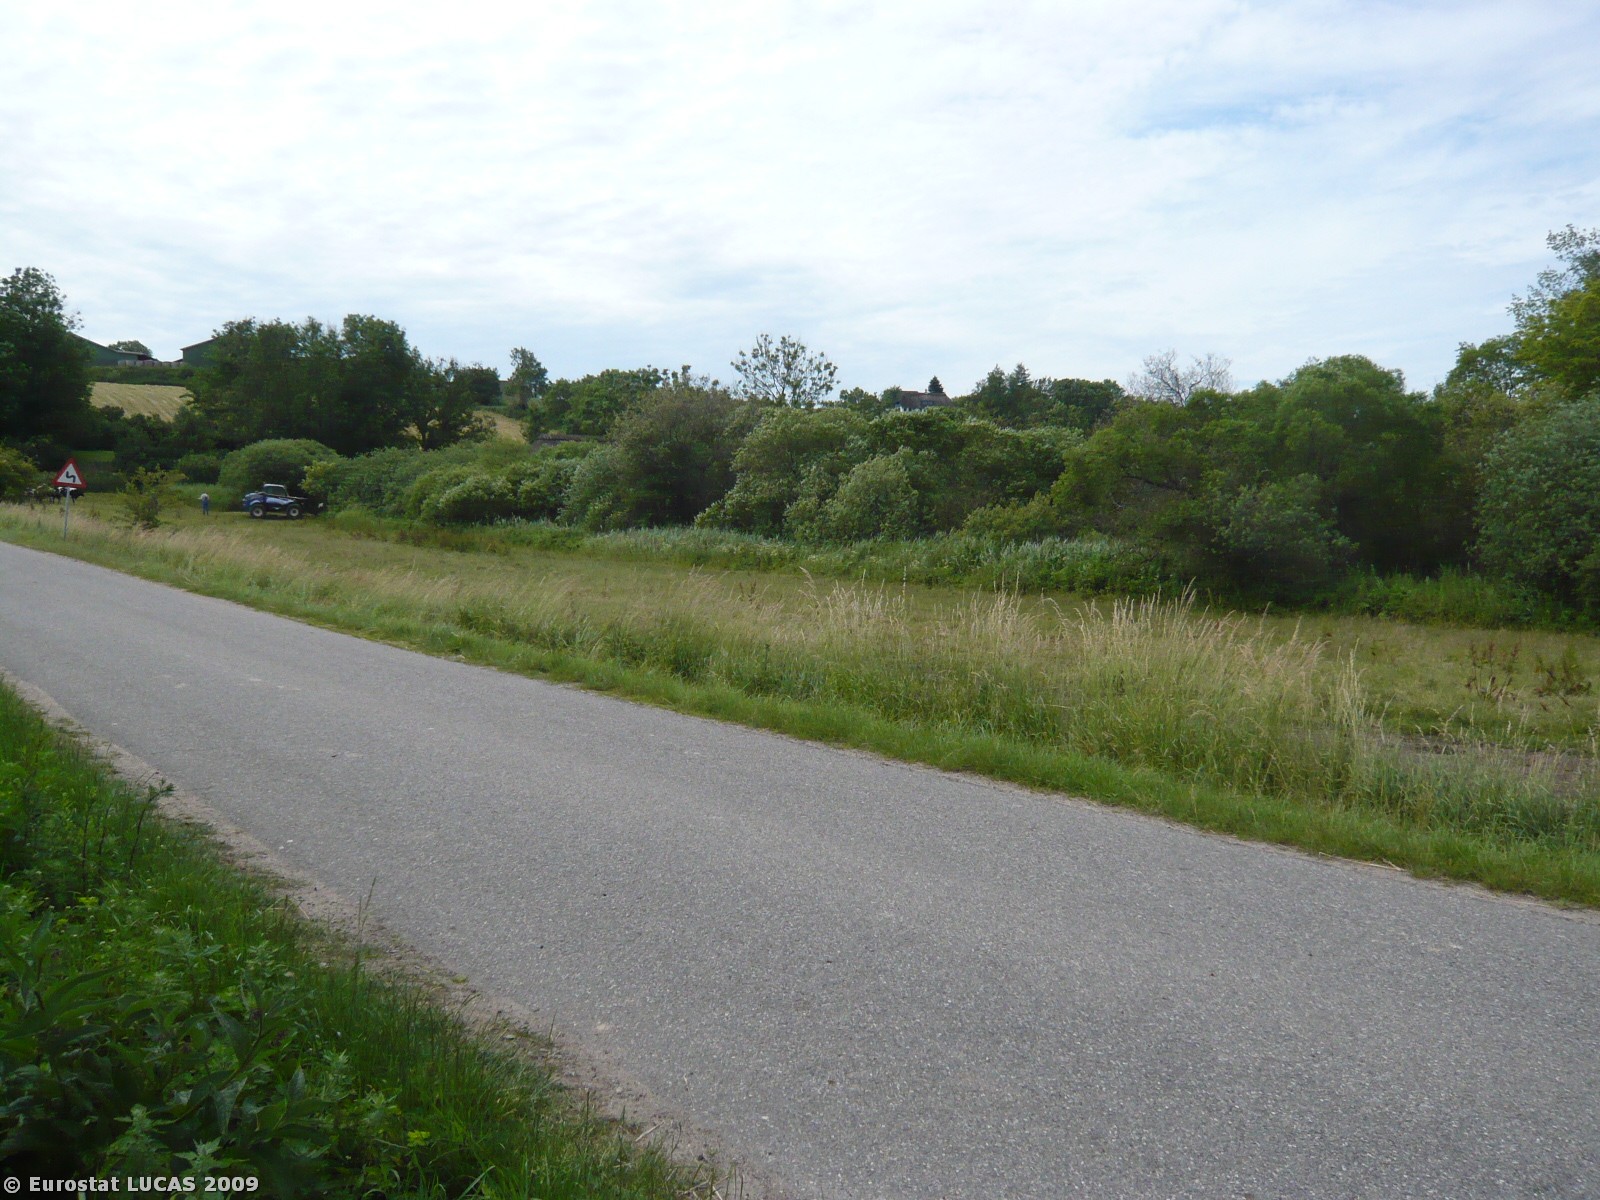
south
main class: Grassland
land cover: Grassland without tree/shrub cover
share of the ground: > 75 %
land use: Agriculture (excluding fallow land and kitchen gardens)
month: June
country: DK
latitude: 55.2156
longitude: 10.6125
